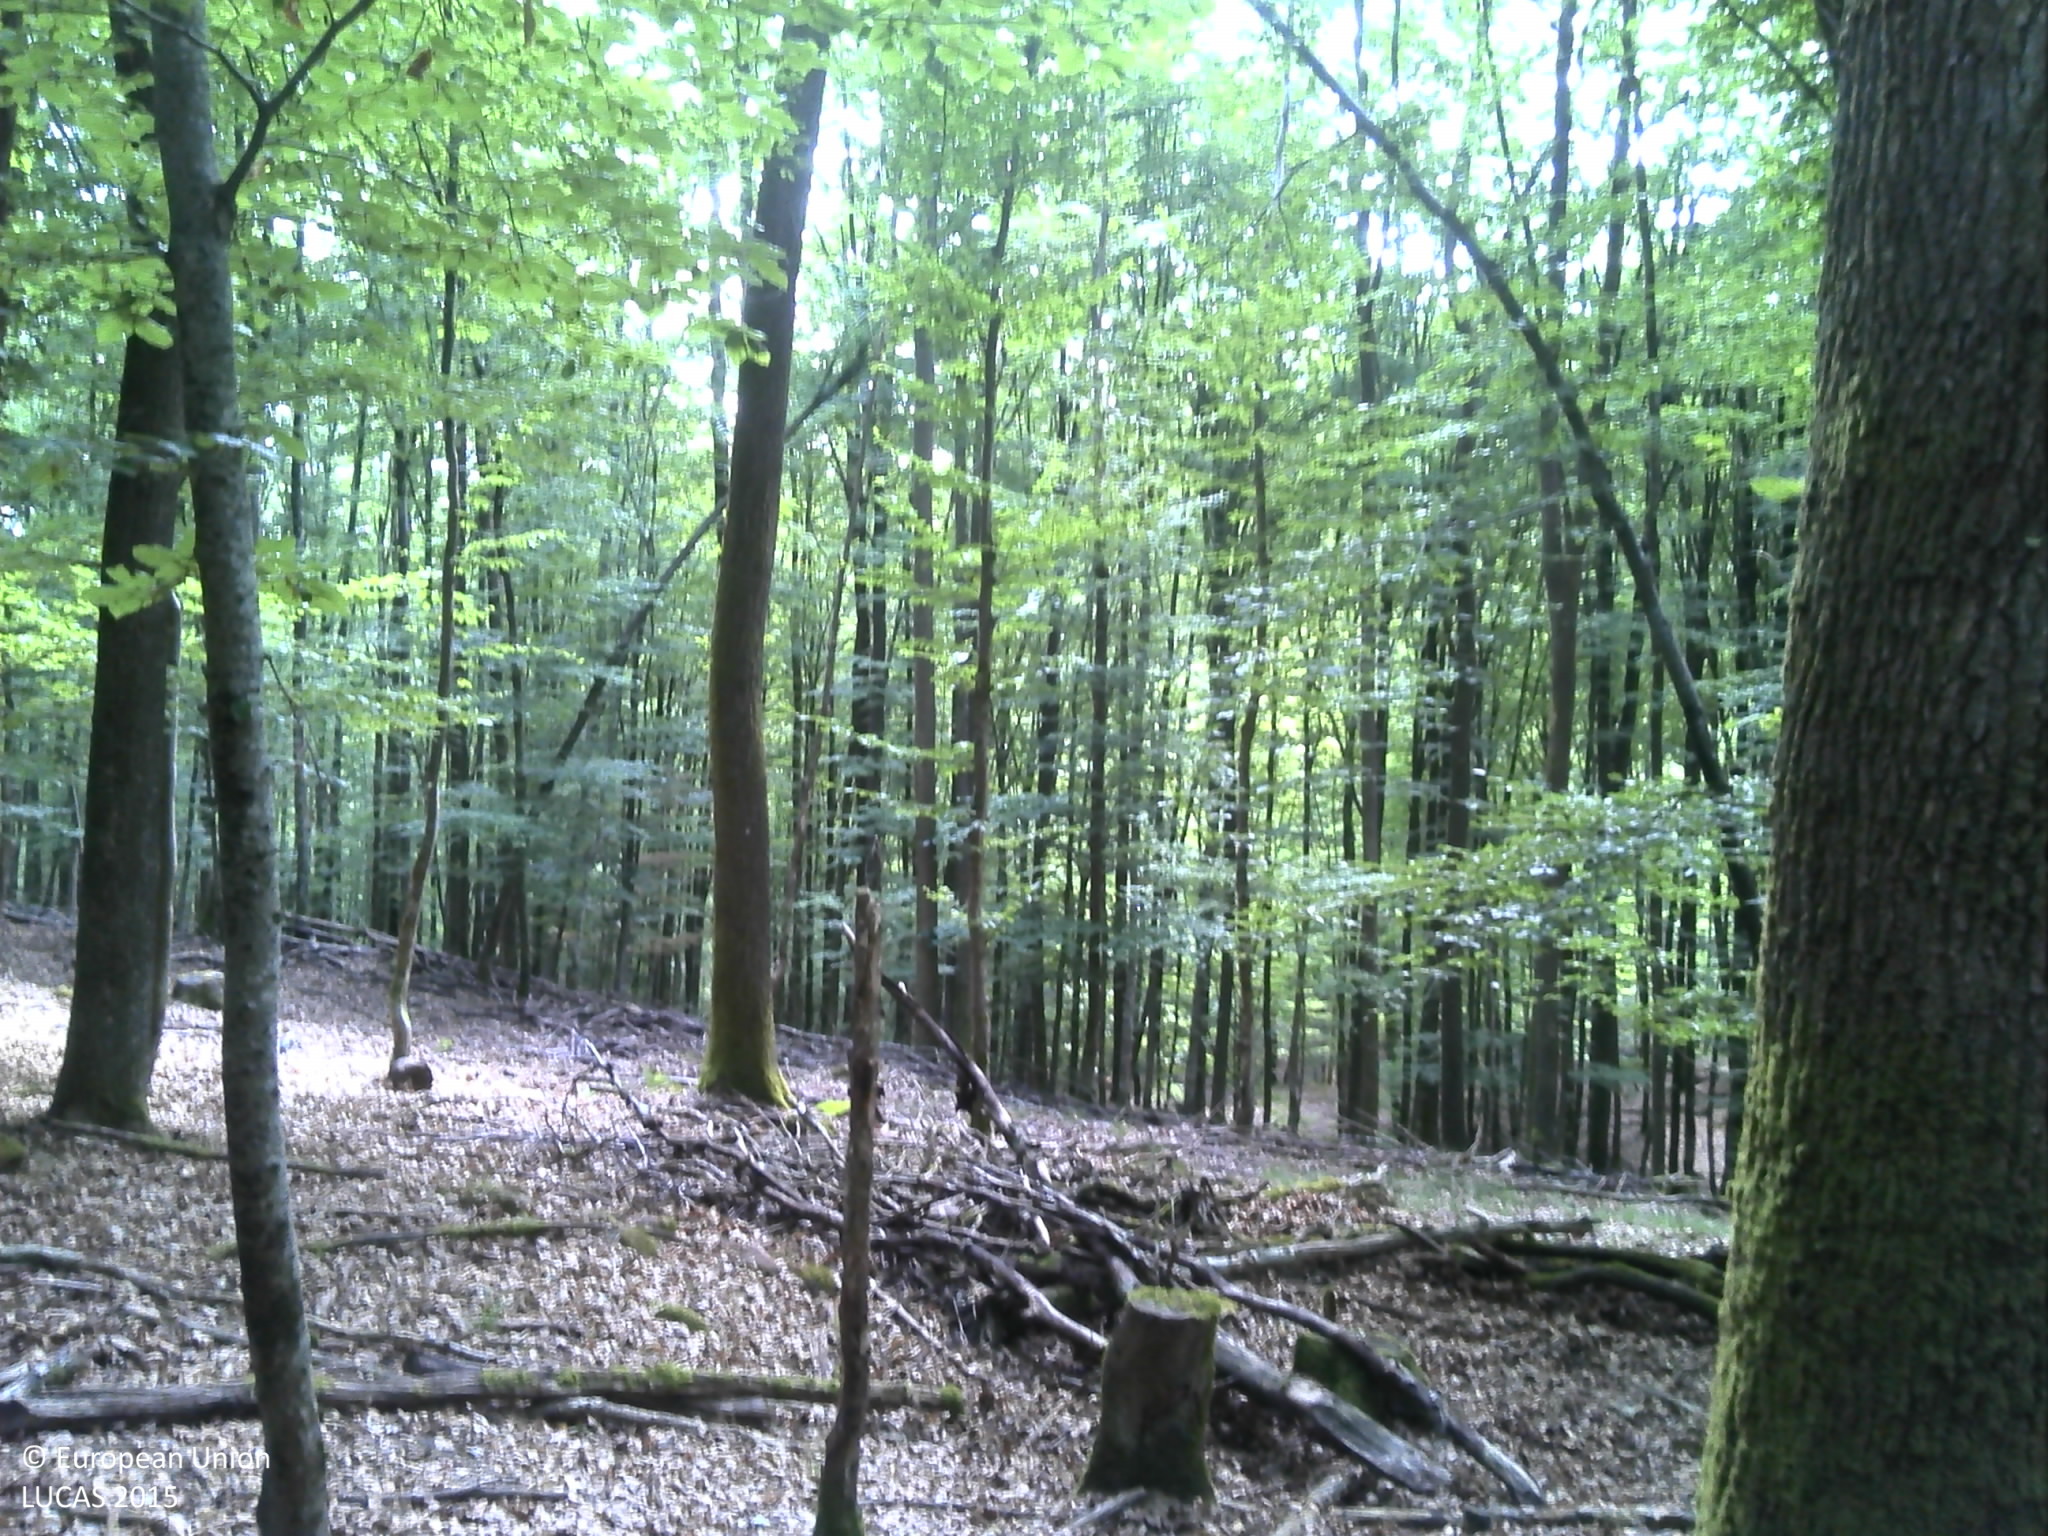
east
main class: Woodland
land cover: Broadleaved woodland
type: acidophilous oak and oak-birch forest
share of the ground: > 75 %
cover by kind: broadleaved forest trees 100 %
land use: Forestry
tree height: > 5 m
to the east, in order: Broadleaved woodland; Tracks; Broadleaved woodland; Rivers and streams; Broadleaved woodland; Tracks; Broadleaved woodland; Tracks; Broadleaved woodland
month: July
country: FR
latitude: 48.9513
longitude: 7.5017
